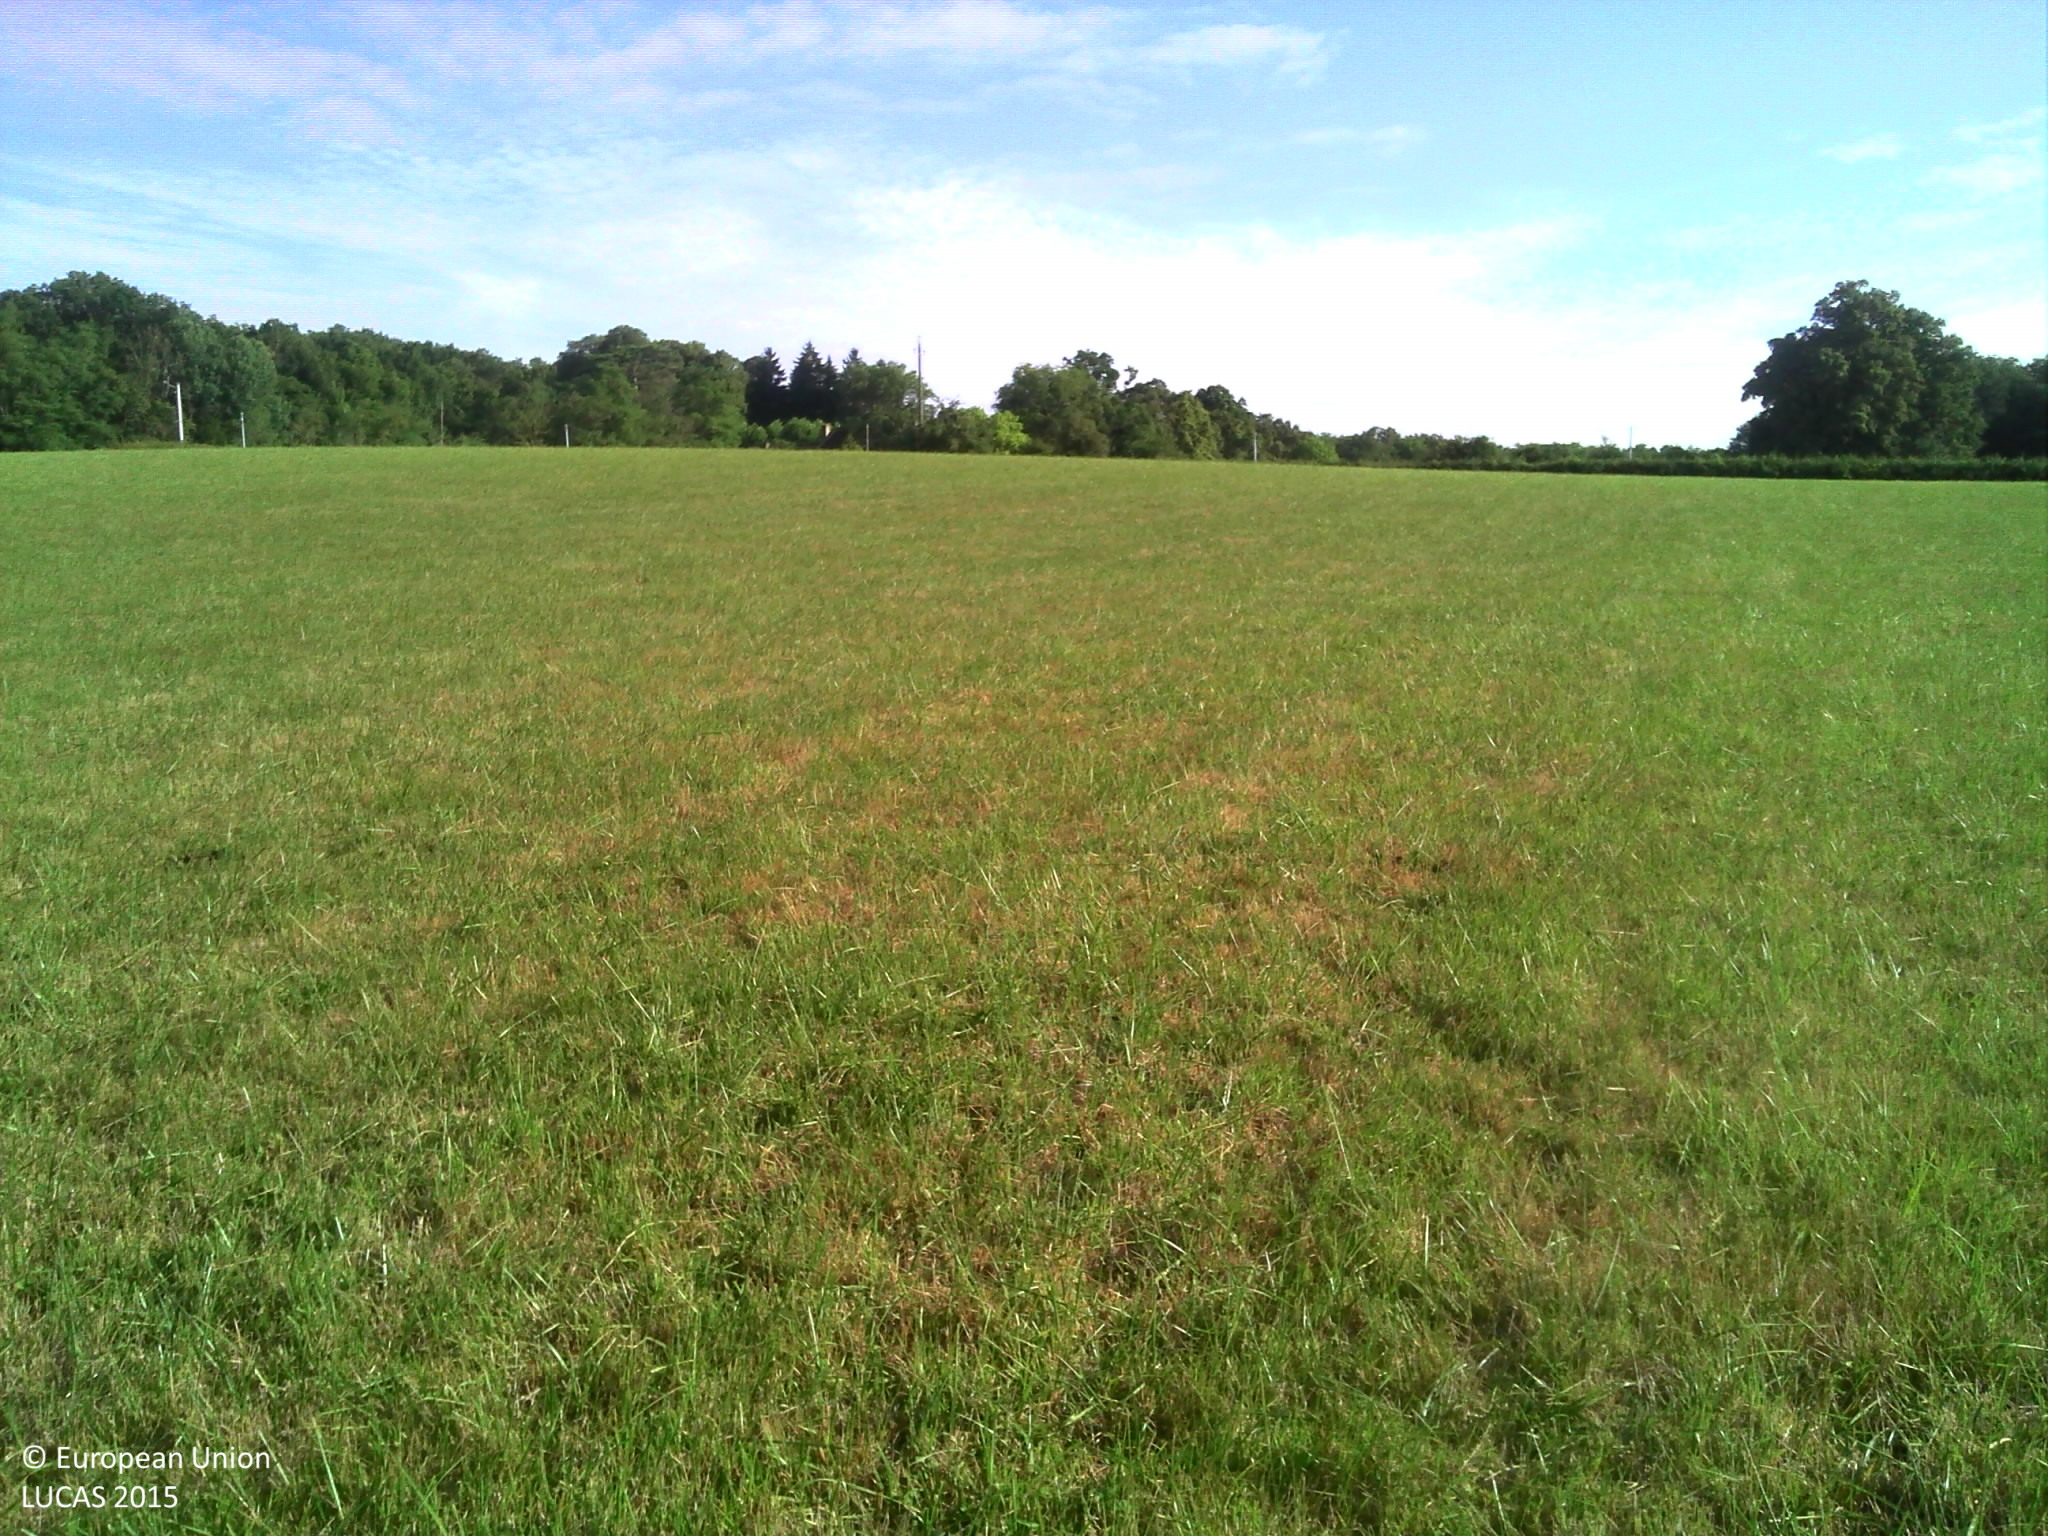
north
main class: Grassland
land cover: Grassland without tree/shrub cover
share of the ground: > 75 %
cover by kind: herbaceous plants 100 %
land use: Agriculture (excluding fallow land and kitchen gardens)
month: July
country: FR
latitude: 47.7576
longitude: 3.4452
